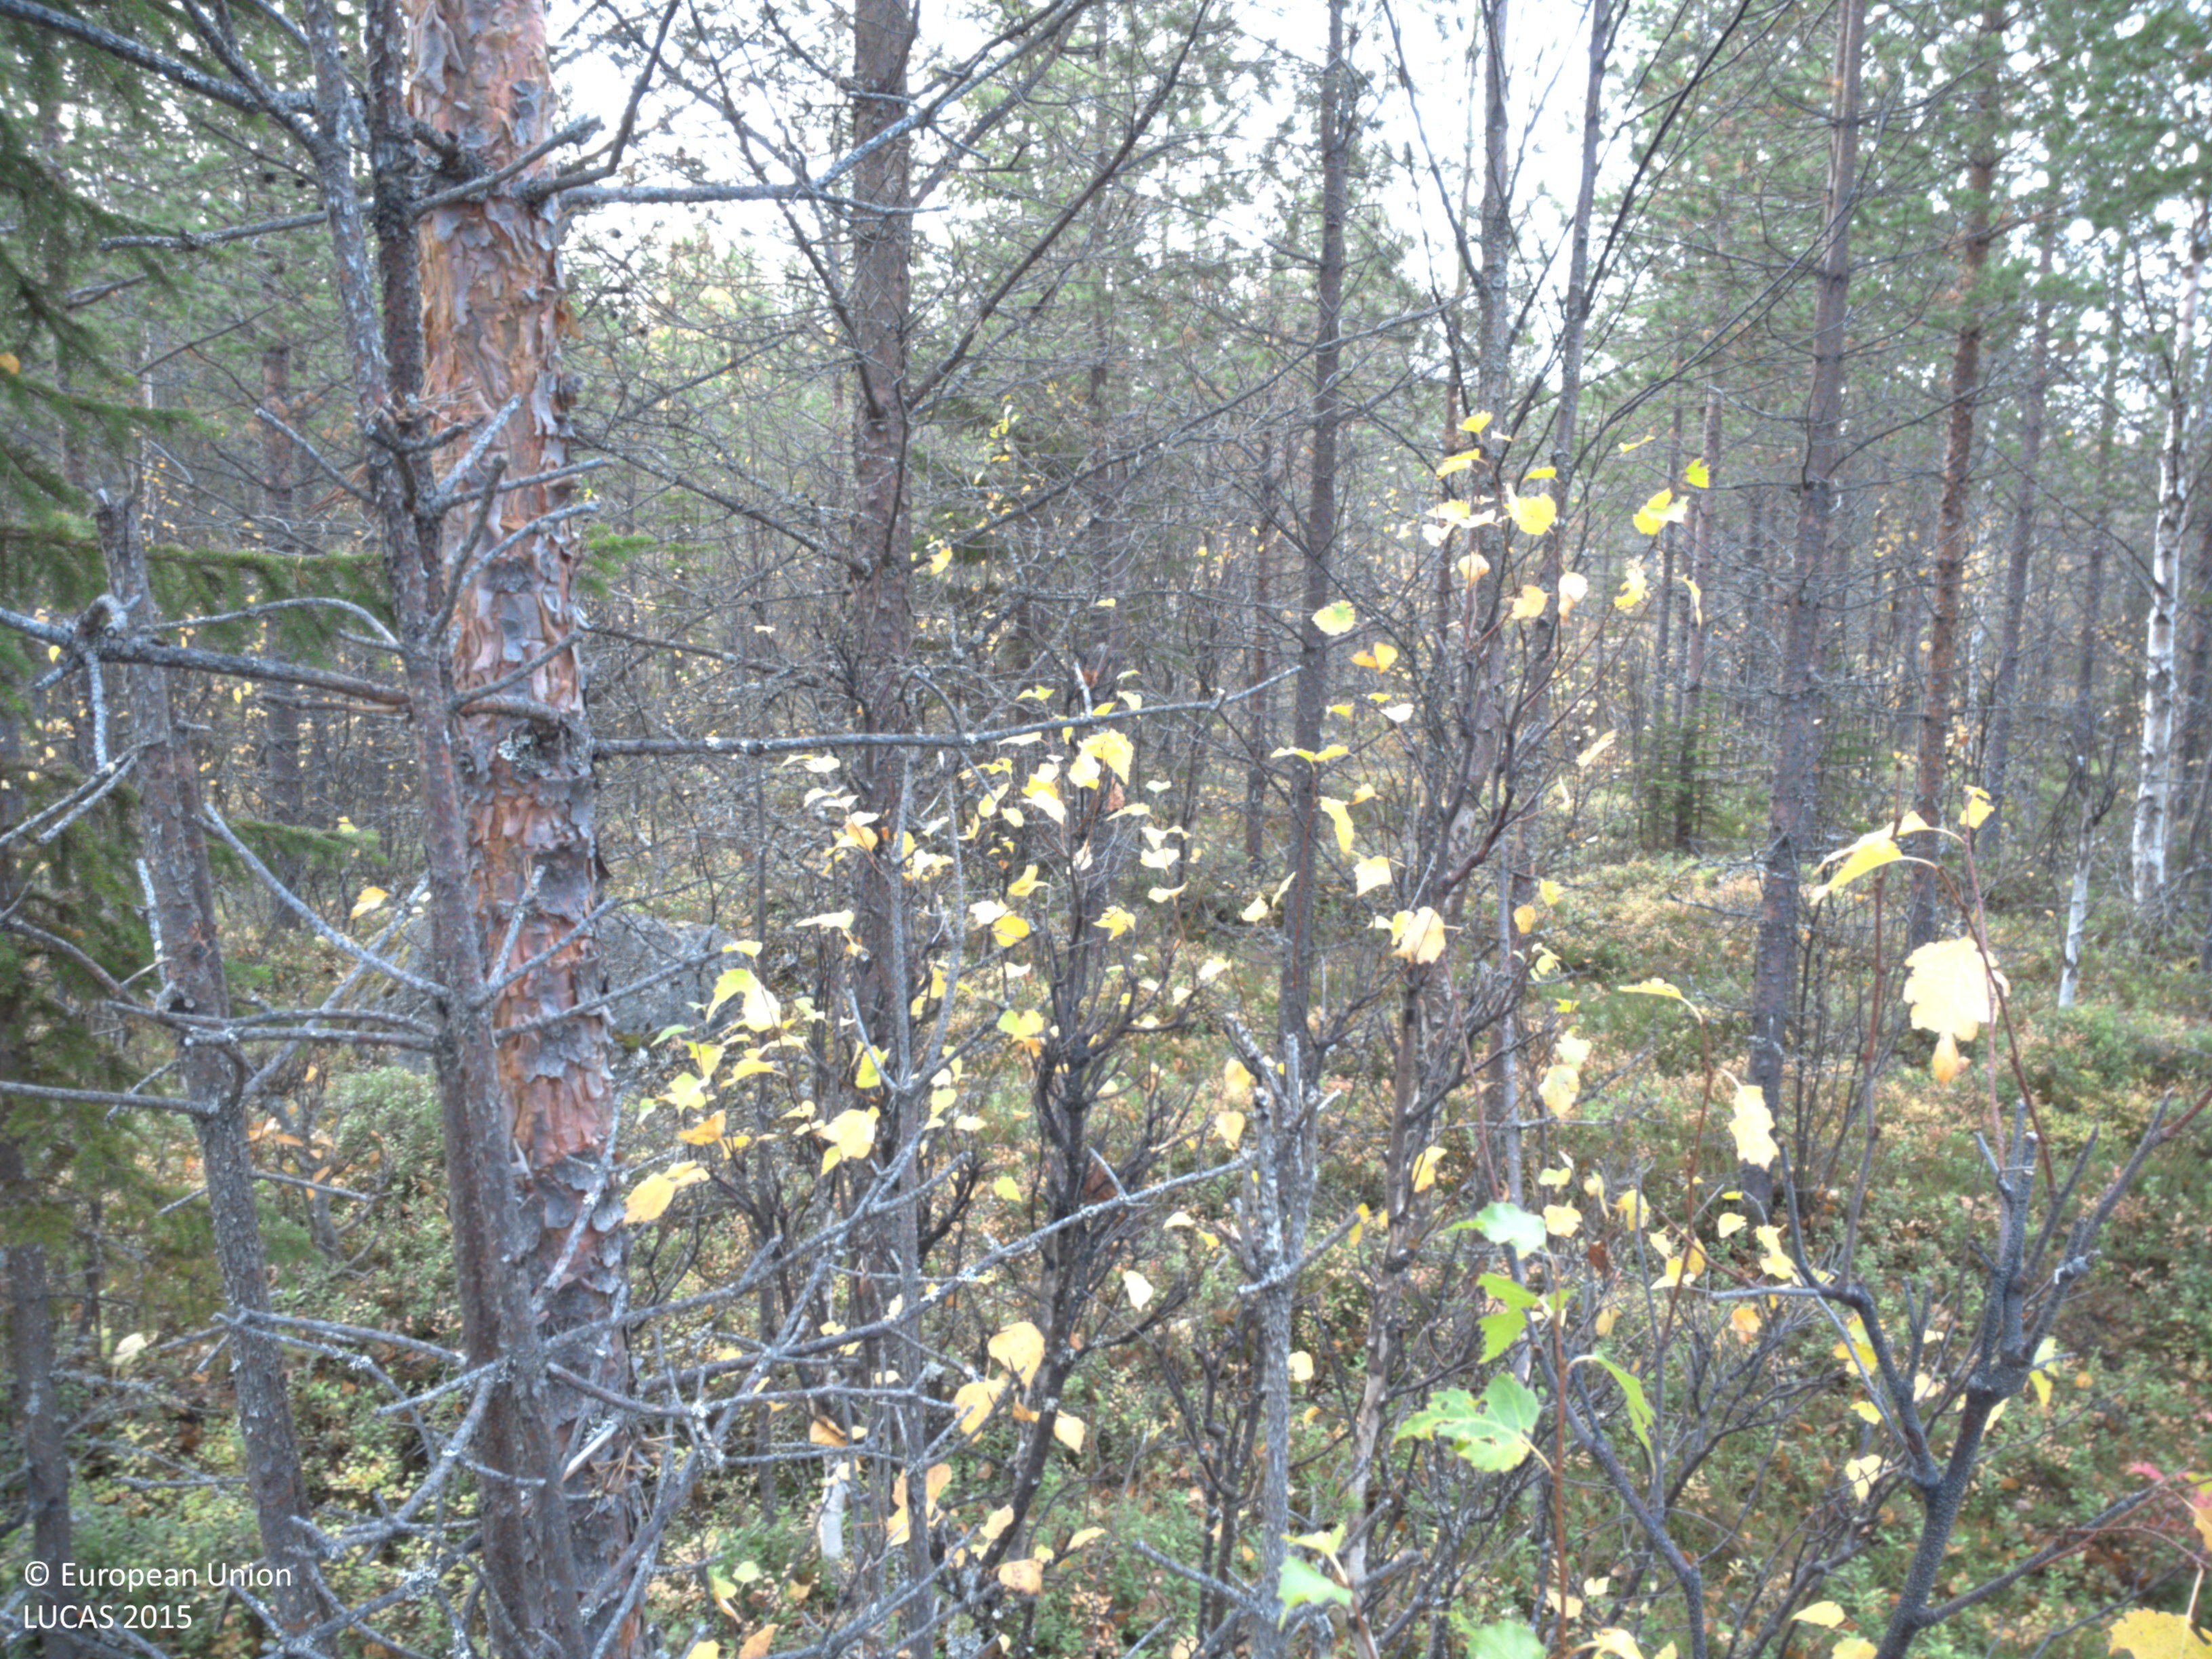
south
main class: Woodland
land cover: Pine dominated coniferous woodland
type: boreal forest
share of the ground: 50 - 75 %
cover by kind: coniferous forest trees 65 %, shrubs 20 %, broadleaved forest trees 5 %, herbaceous plants 5 %, lichens and mosses 5 %
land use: Forestry
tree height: < 5 m
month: October
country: SE
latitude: 64.6787
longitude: 18.1599
